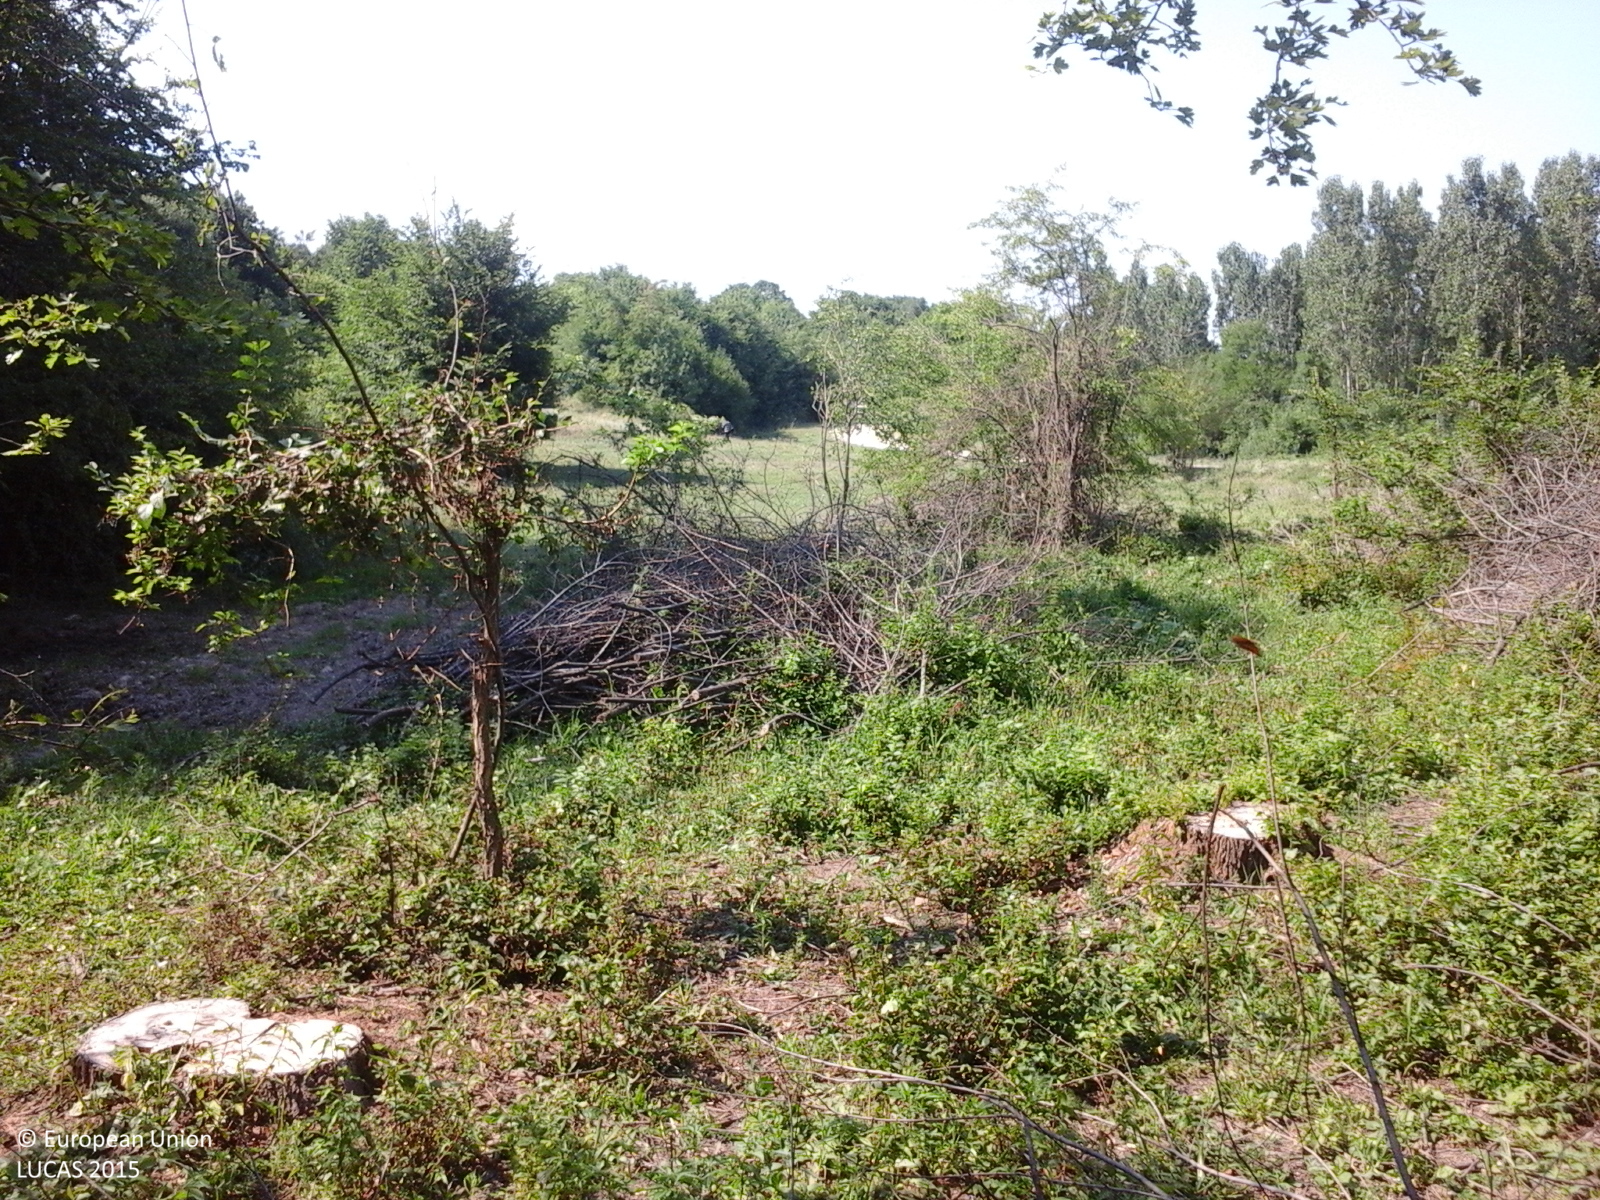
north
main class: Woodland
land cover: Broadleaved woodland
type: floodplain forest
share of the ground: > 75 %
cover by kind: broadleaved forest trees 90 %, shrubs 5 %, herbaceous plants 5 %
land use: Forestry
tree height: < 5 m
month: July
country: RO
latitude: 44.7304
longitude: 24.7891
